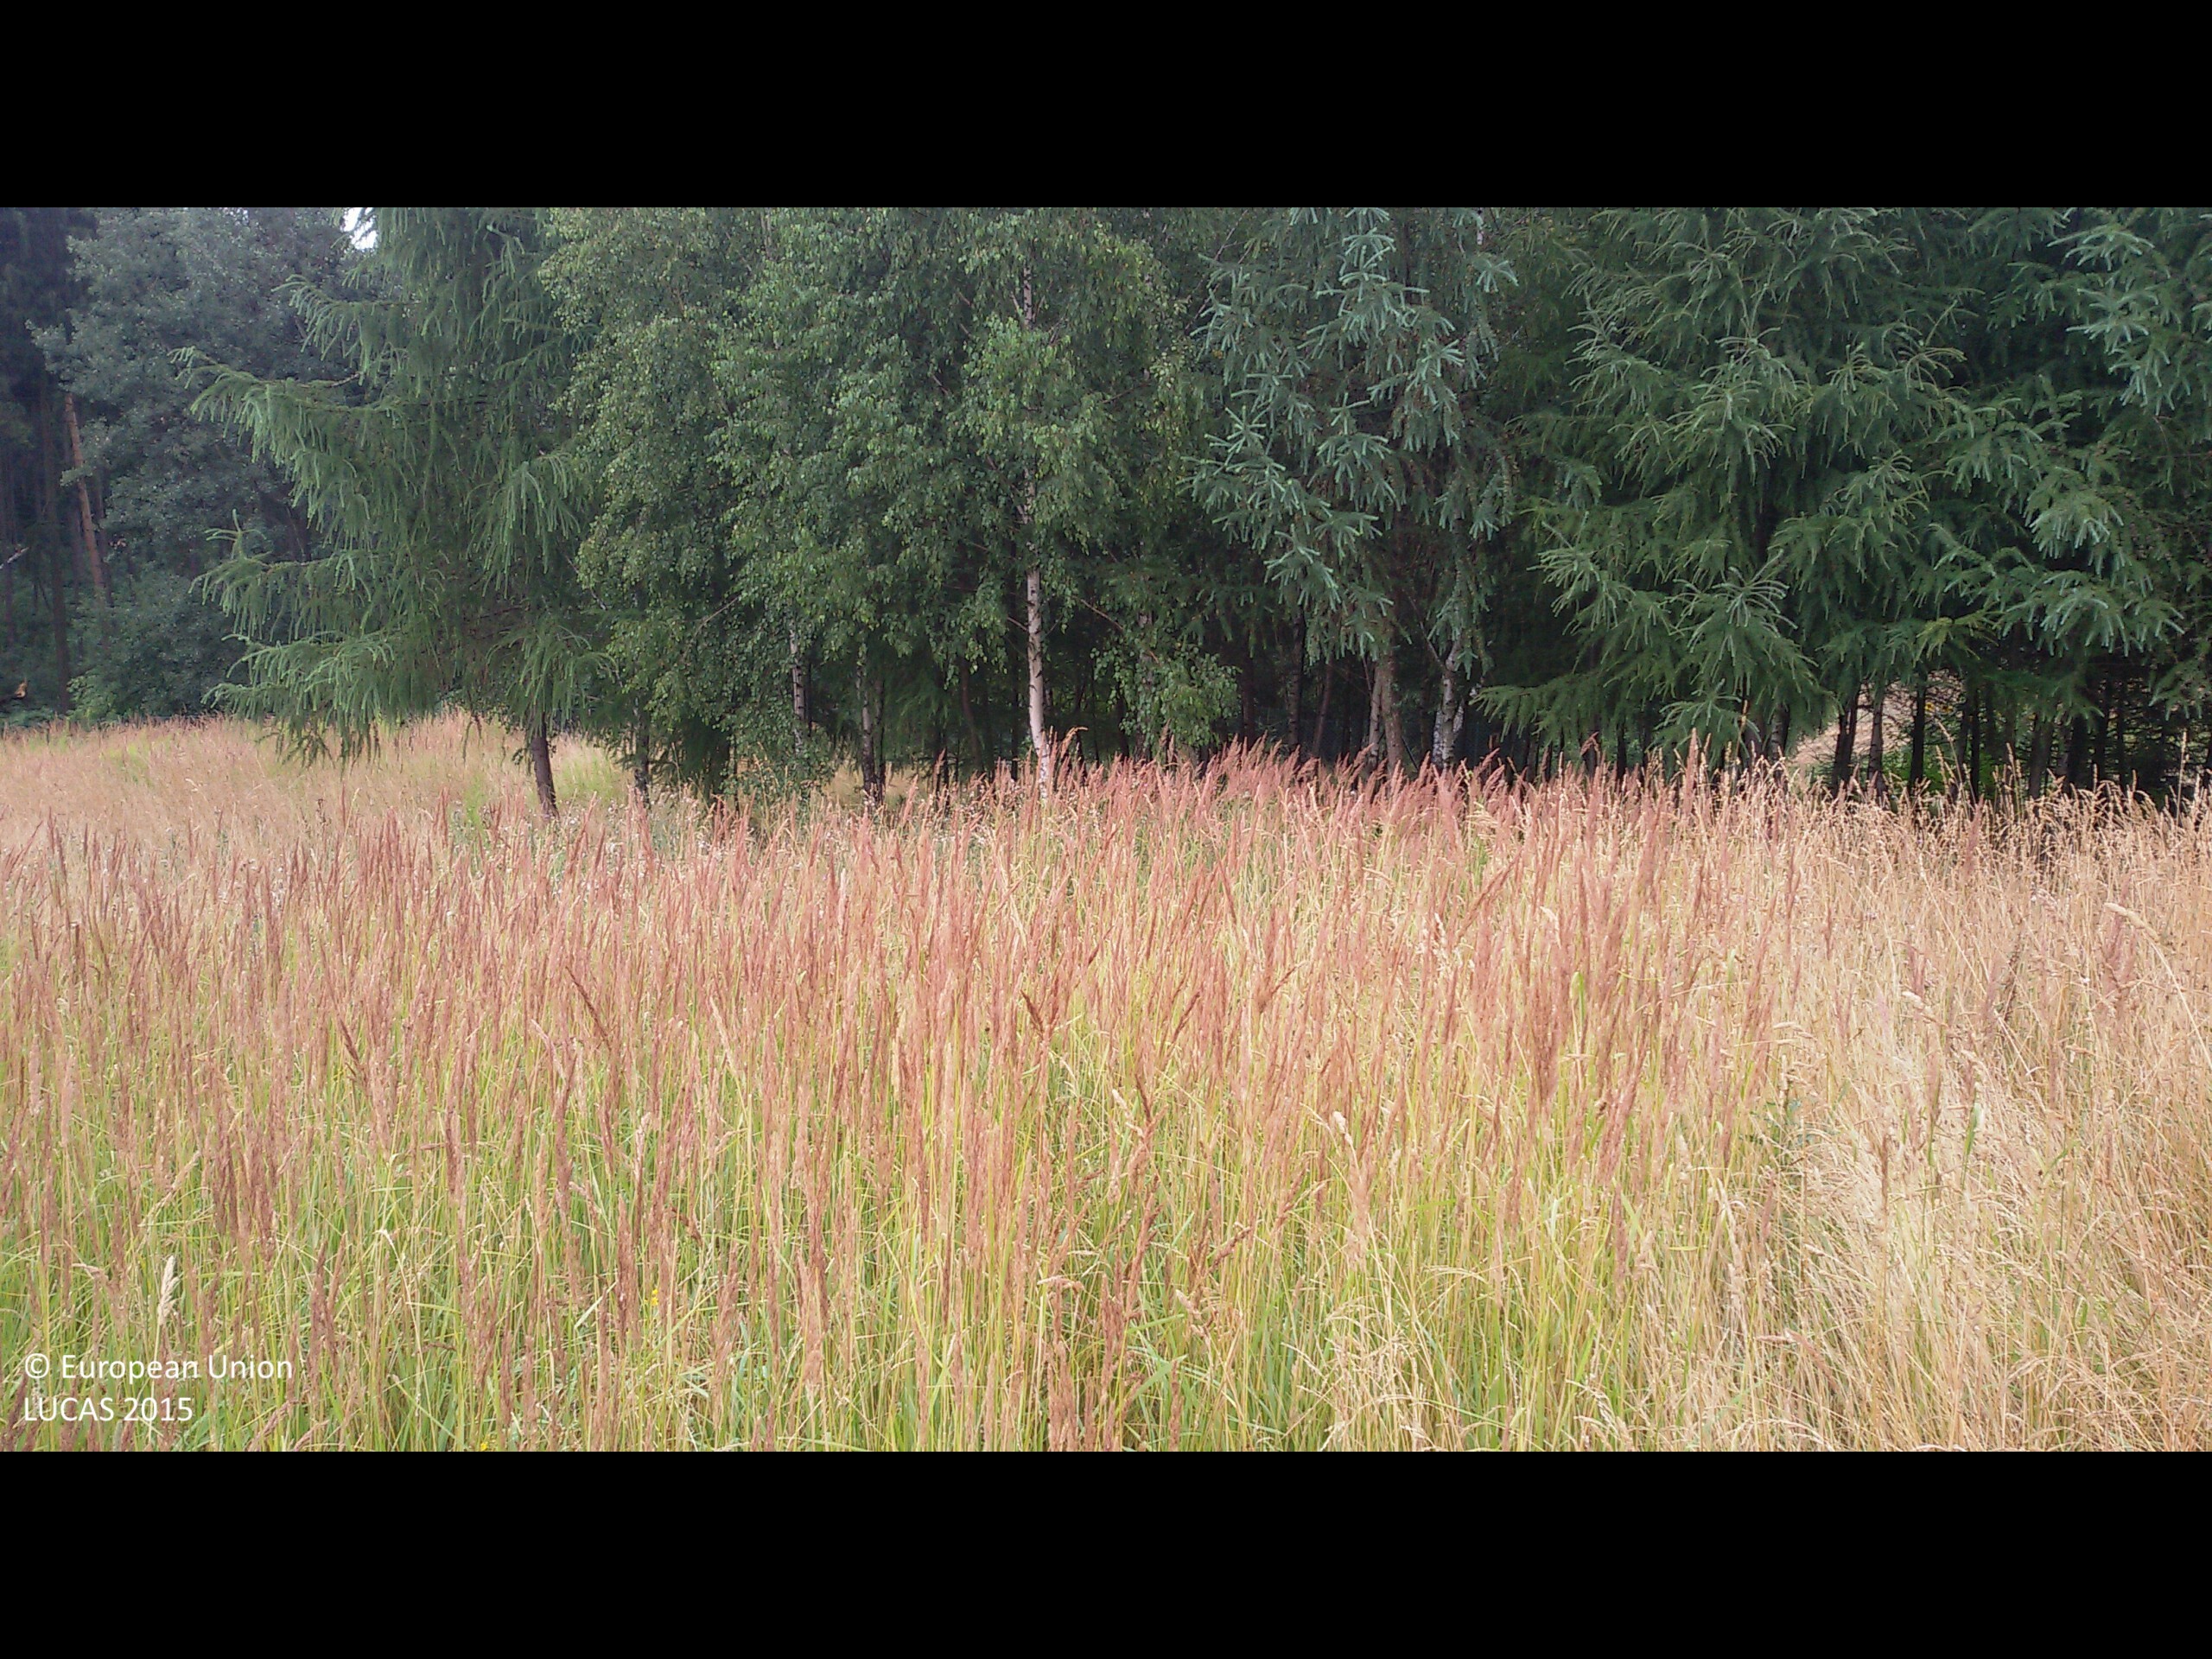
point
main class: Grassland
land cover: Grassland without tree/shrub cover
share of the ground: > 75 %
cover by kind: herbaceous plants 100 %
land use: Agriculture (excluding fallow land and kitchen gardens)
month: July
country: PL
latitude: 50.0056
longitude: 18.5725
